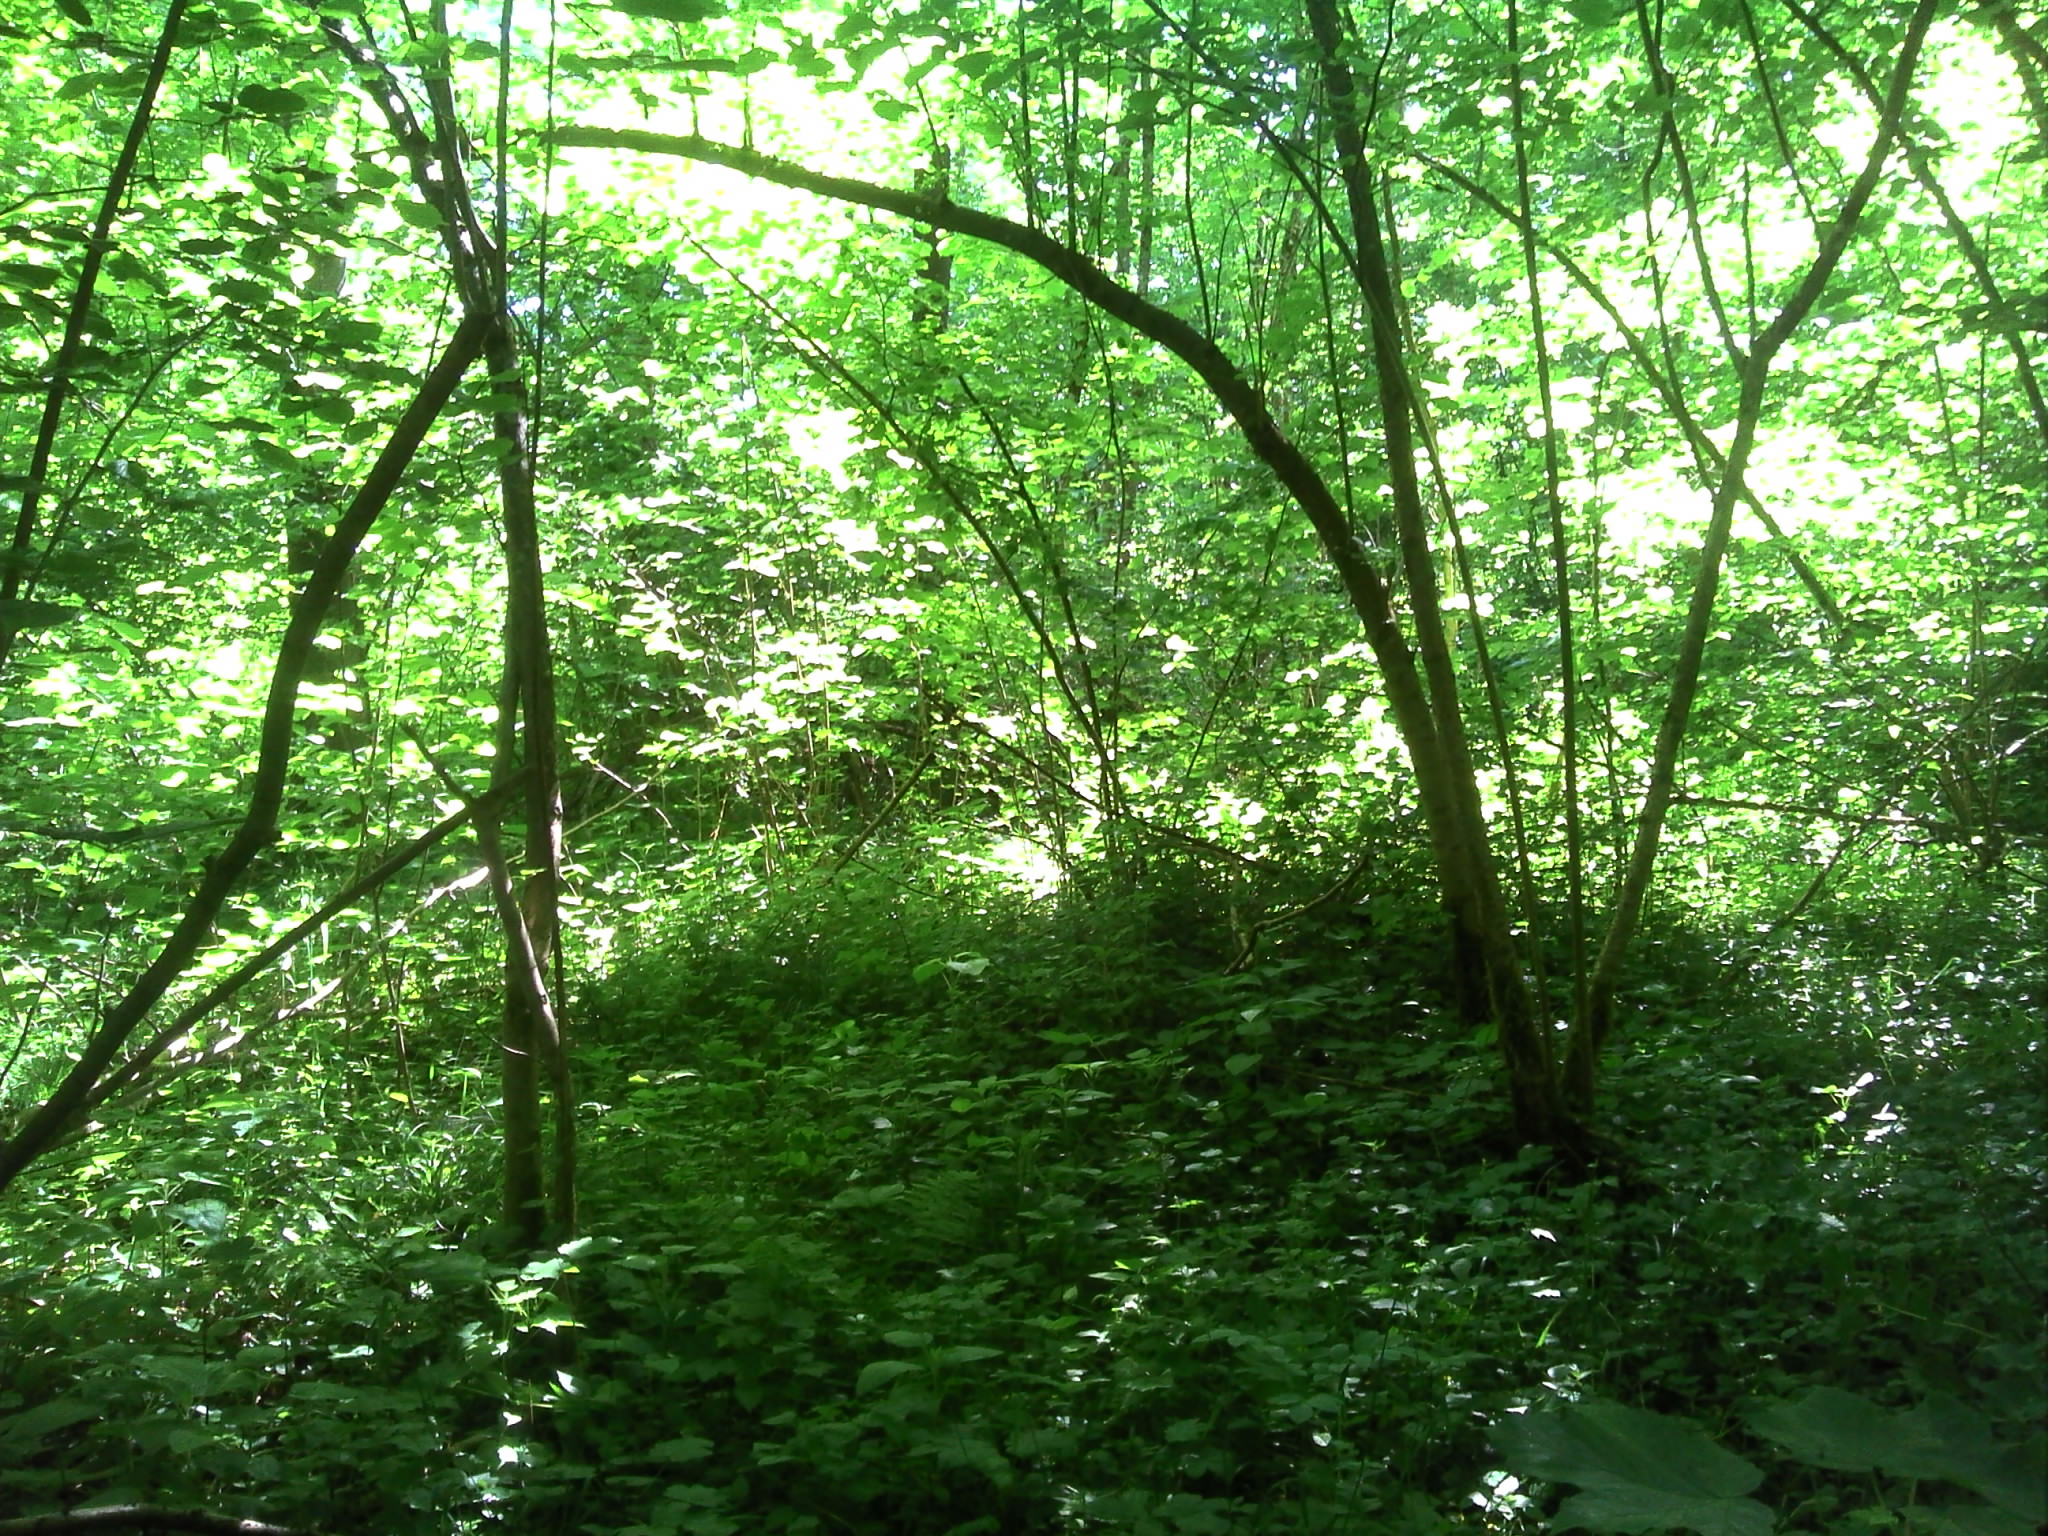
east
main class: Woodland
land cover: Broadleaved woodland
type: mesophytic deciduous forest
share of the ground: > 75 %
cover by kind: broadleaved forest trees 100 %
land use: Forestry
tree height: > 5 m
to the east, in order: Broadleaved woodland; Grass margins; Paved roads, cycling and walking lanes; Grass margins; Rape and turnip rape; Grass margins; Paved roads, cycling and walking lanes; Grass margins; Spontaneously vegetated surfaces
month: June
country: BE
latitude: 50.2998
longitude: 5.2104
